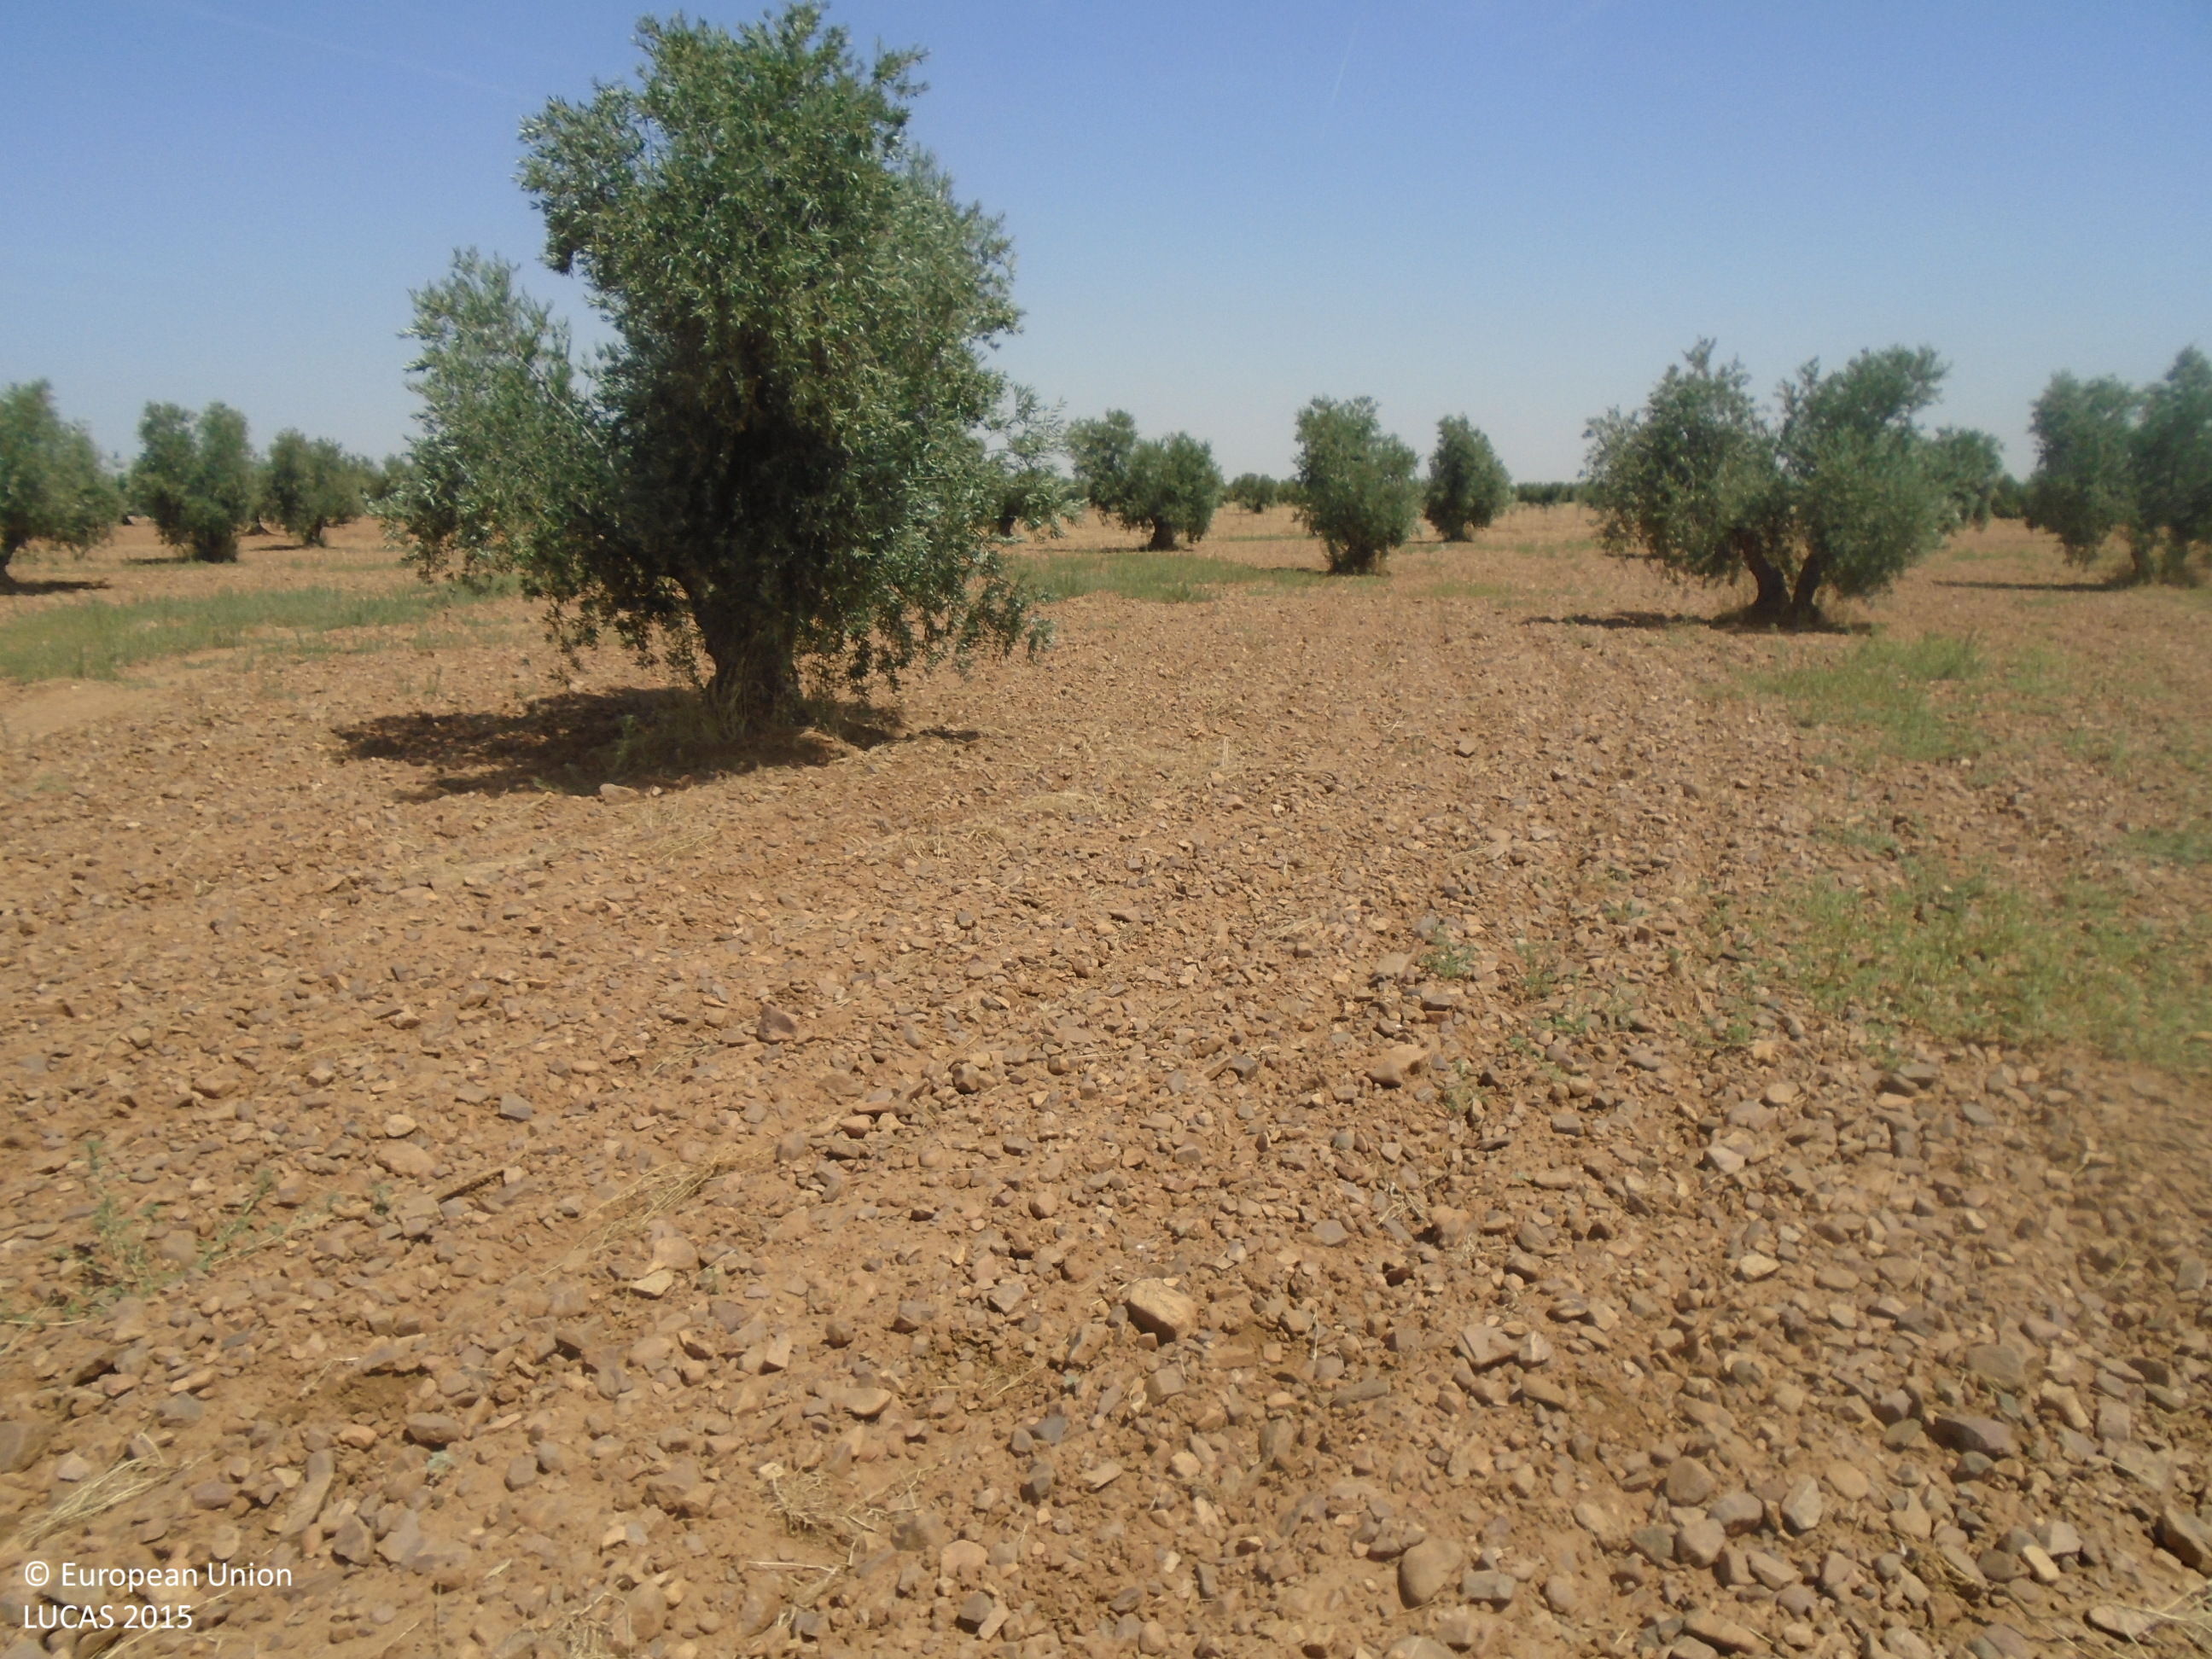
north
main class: Cropland
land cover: Olive groves
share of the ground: 25 - 50 %
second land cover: Other bare soil
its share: > 75 %
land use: Agriculture (excluding fallow land and kitchen gardens)
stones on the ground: 25 - 50 %
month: July
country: ES
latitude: 39.4283
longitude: -3.5797
